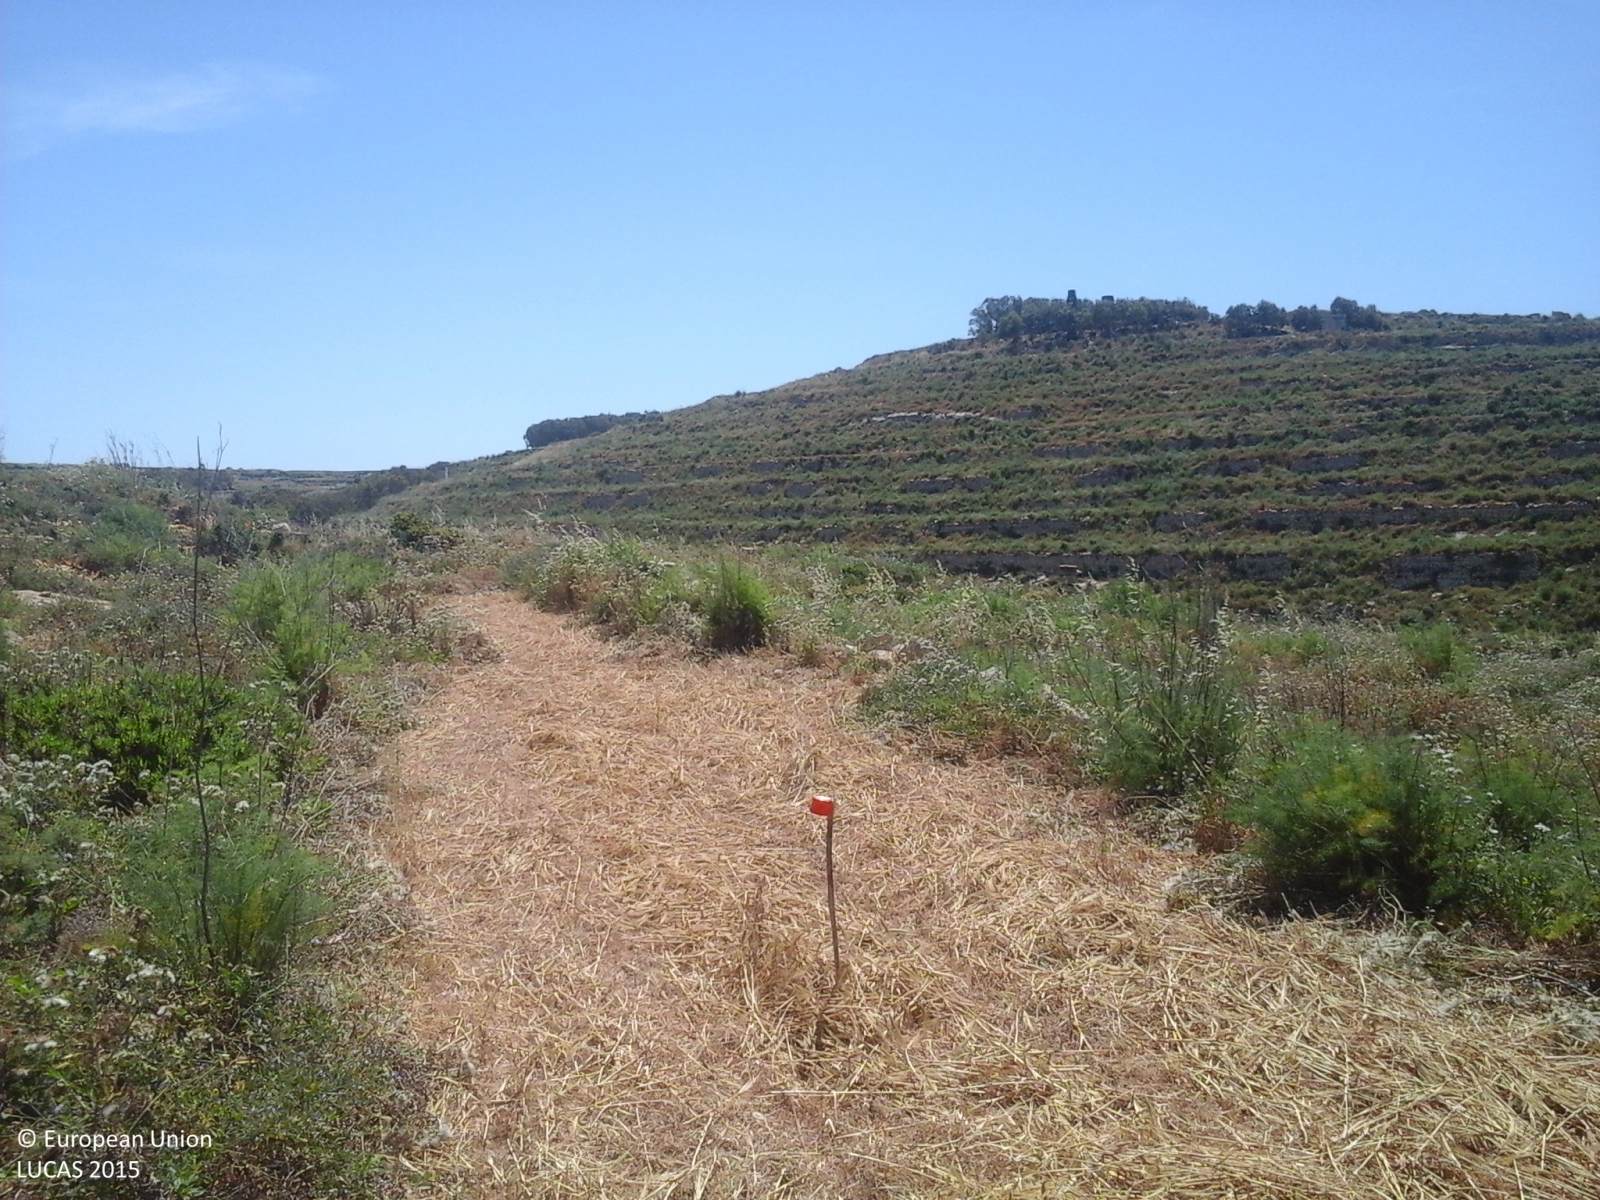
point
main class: Cropland
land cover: Mixed cereals for fodder
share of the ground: > 75 %
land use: Agriculture (excluding fallow land and kitchen gardens)
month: May
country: MT
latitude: 36.0723
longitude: 14.1923
